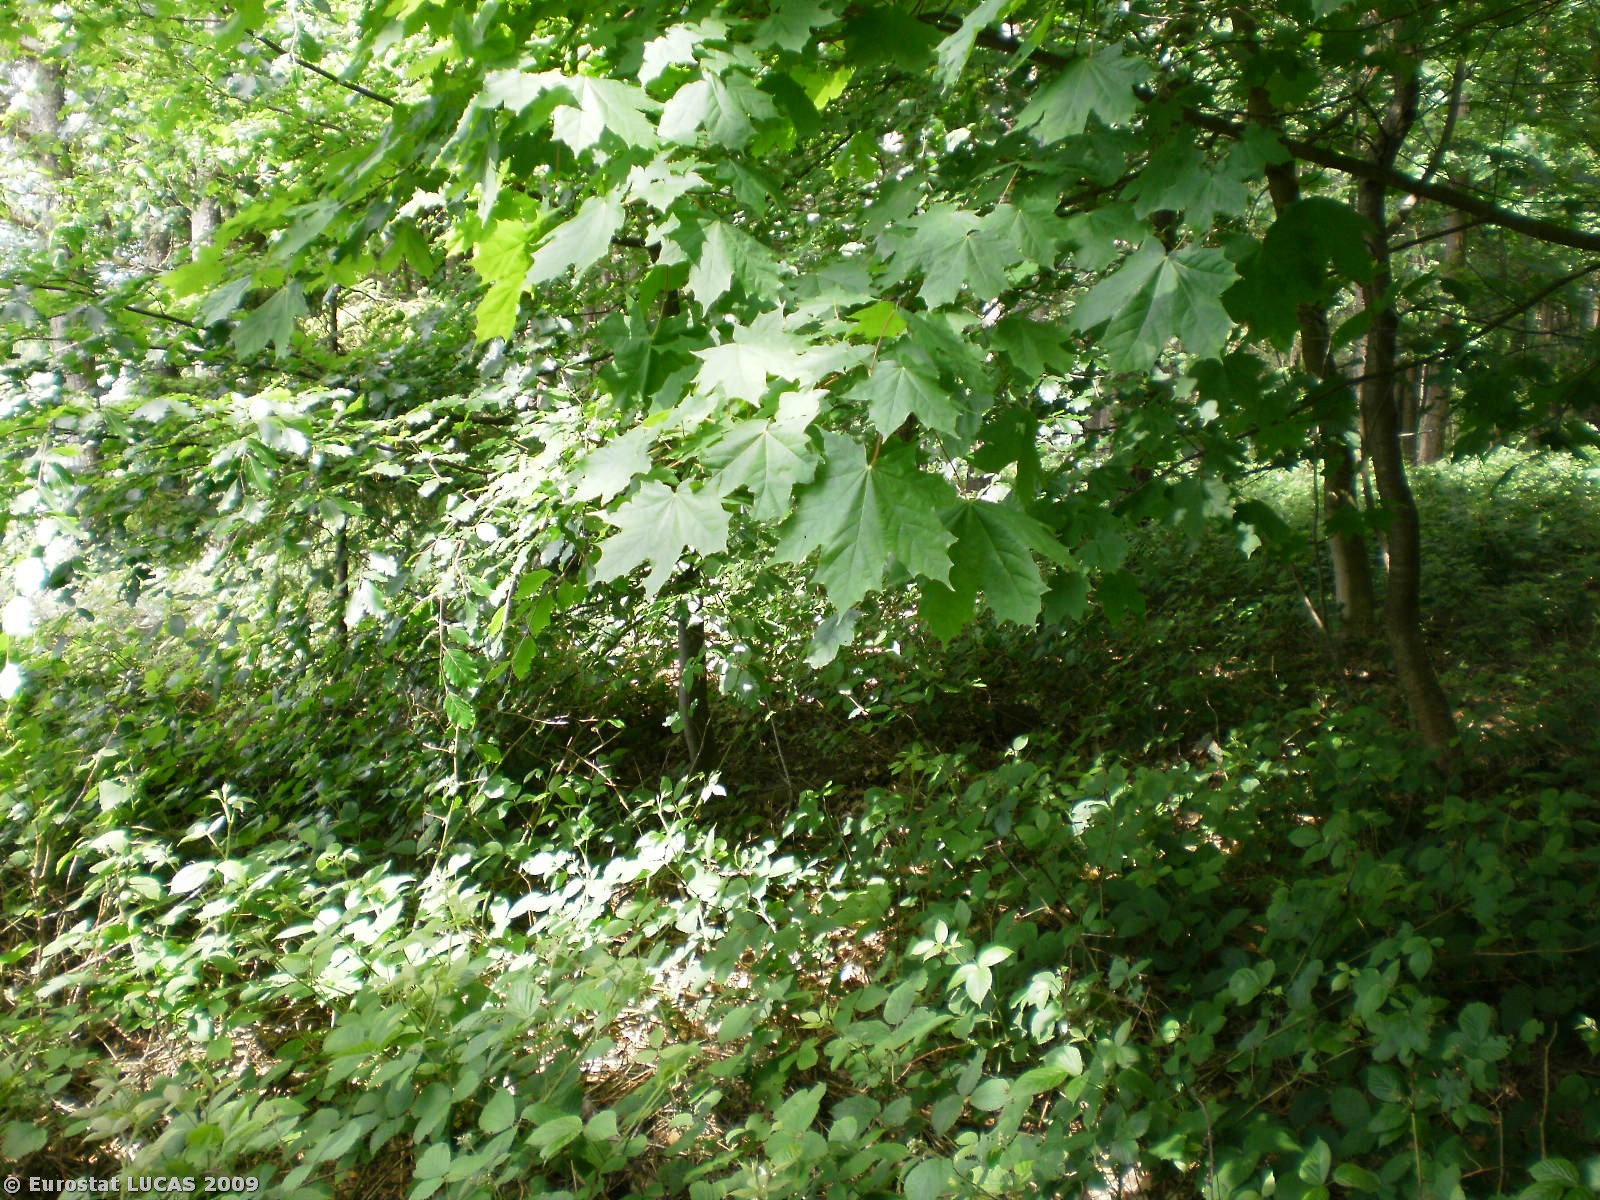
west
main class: Woodland
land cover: Mixed woodland
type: hemiboreal forest and nemoral coniferous forest and mixed broadleaved-coniferous forest
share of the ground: > 75 %
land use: Unused
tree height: > 5 m
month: June
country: PL
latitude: 54.4289
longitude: 17.8587
